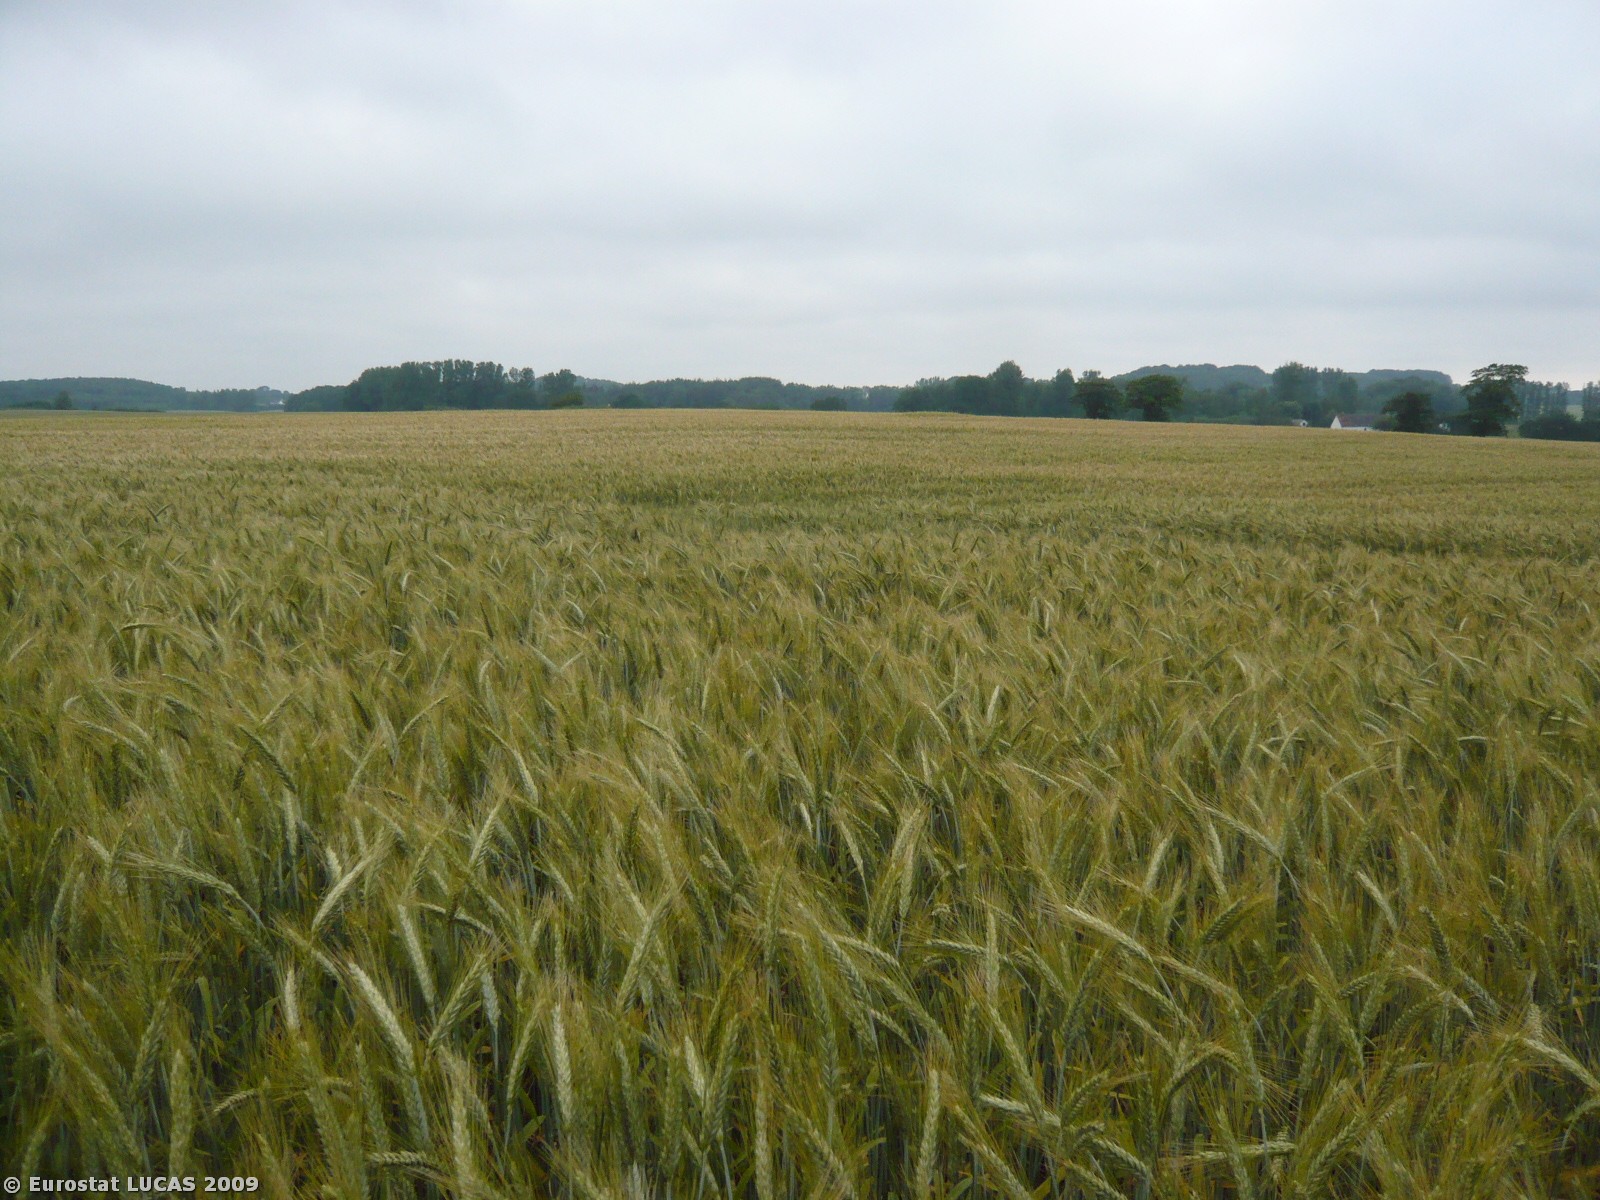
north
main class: Cropland
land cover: Triticale
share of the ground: > 75 %
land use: Agriculture (excluding fallow land and kitchen gardens)
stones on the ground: < 10 %
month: June
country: DK
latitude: 55.1990
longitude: 10.2041
